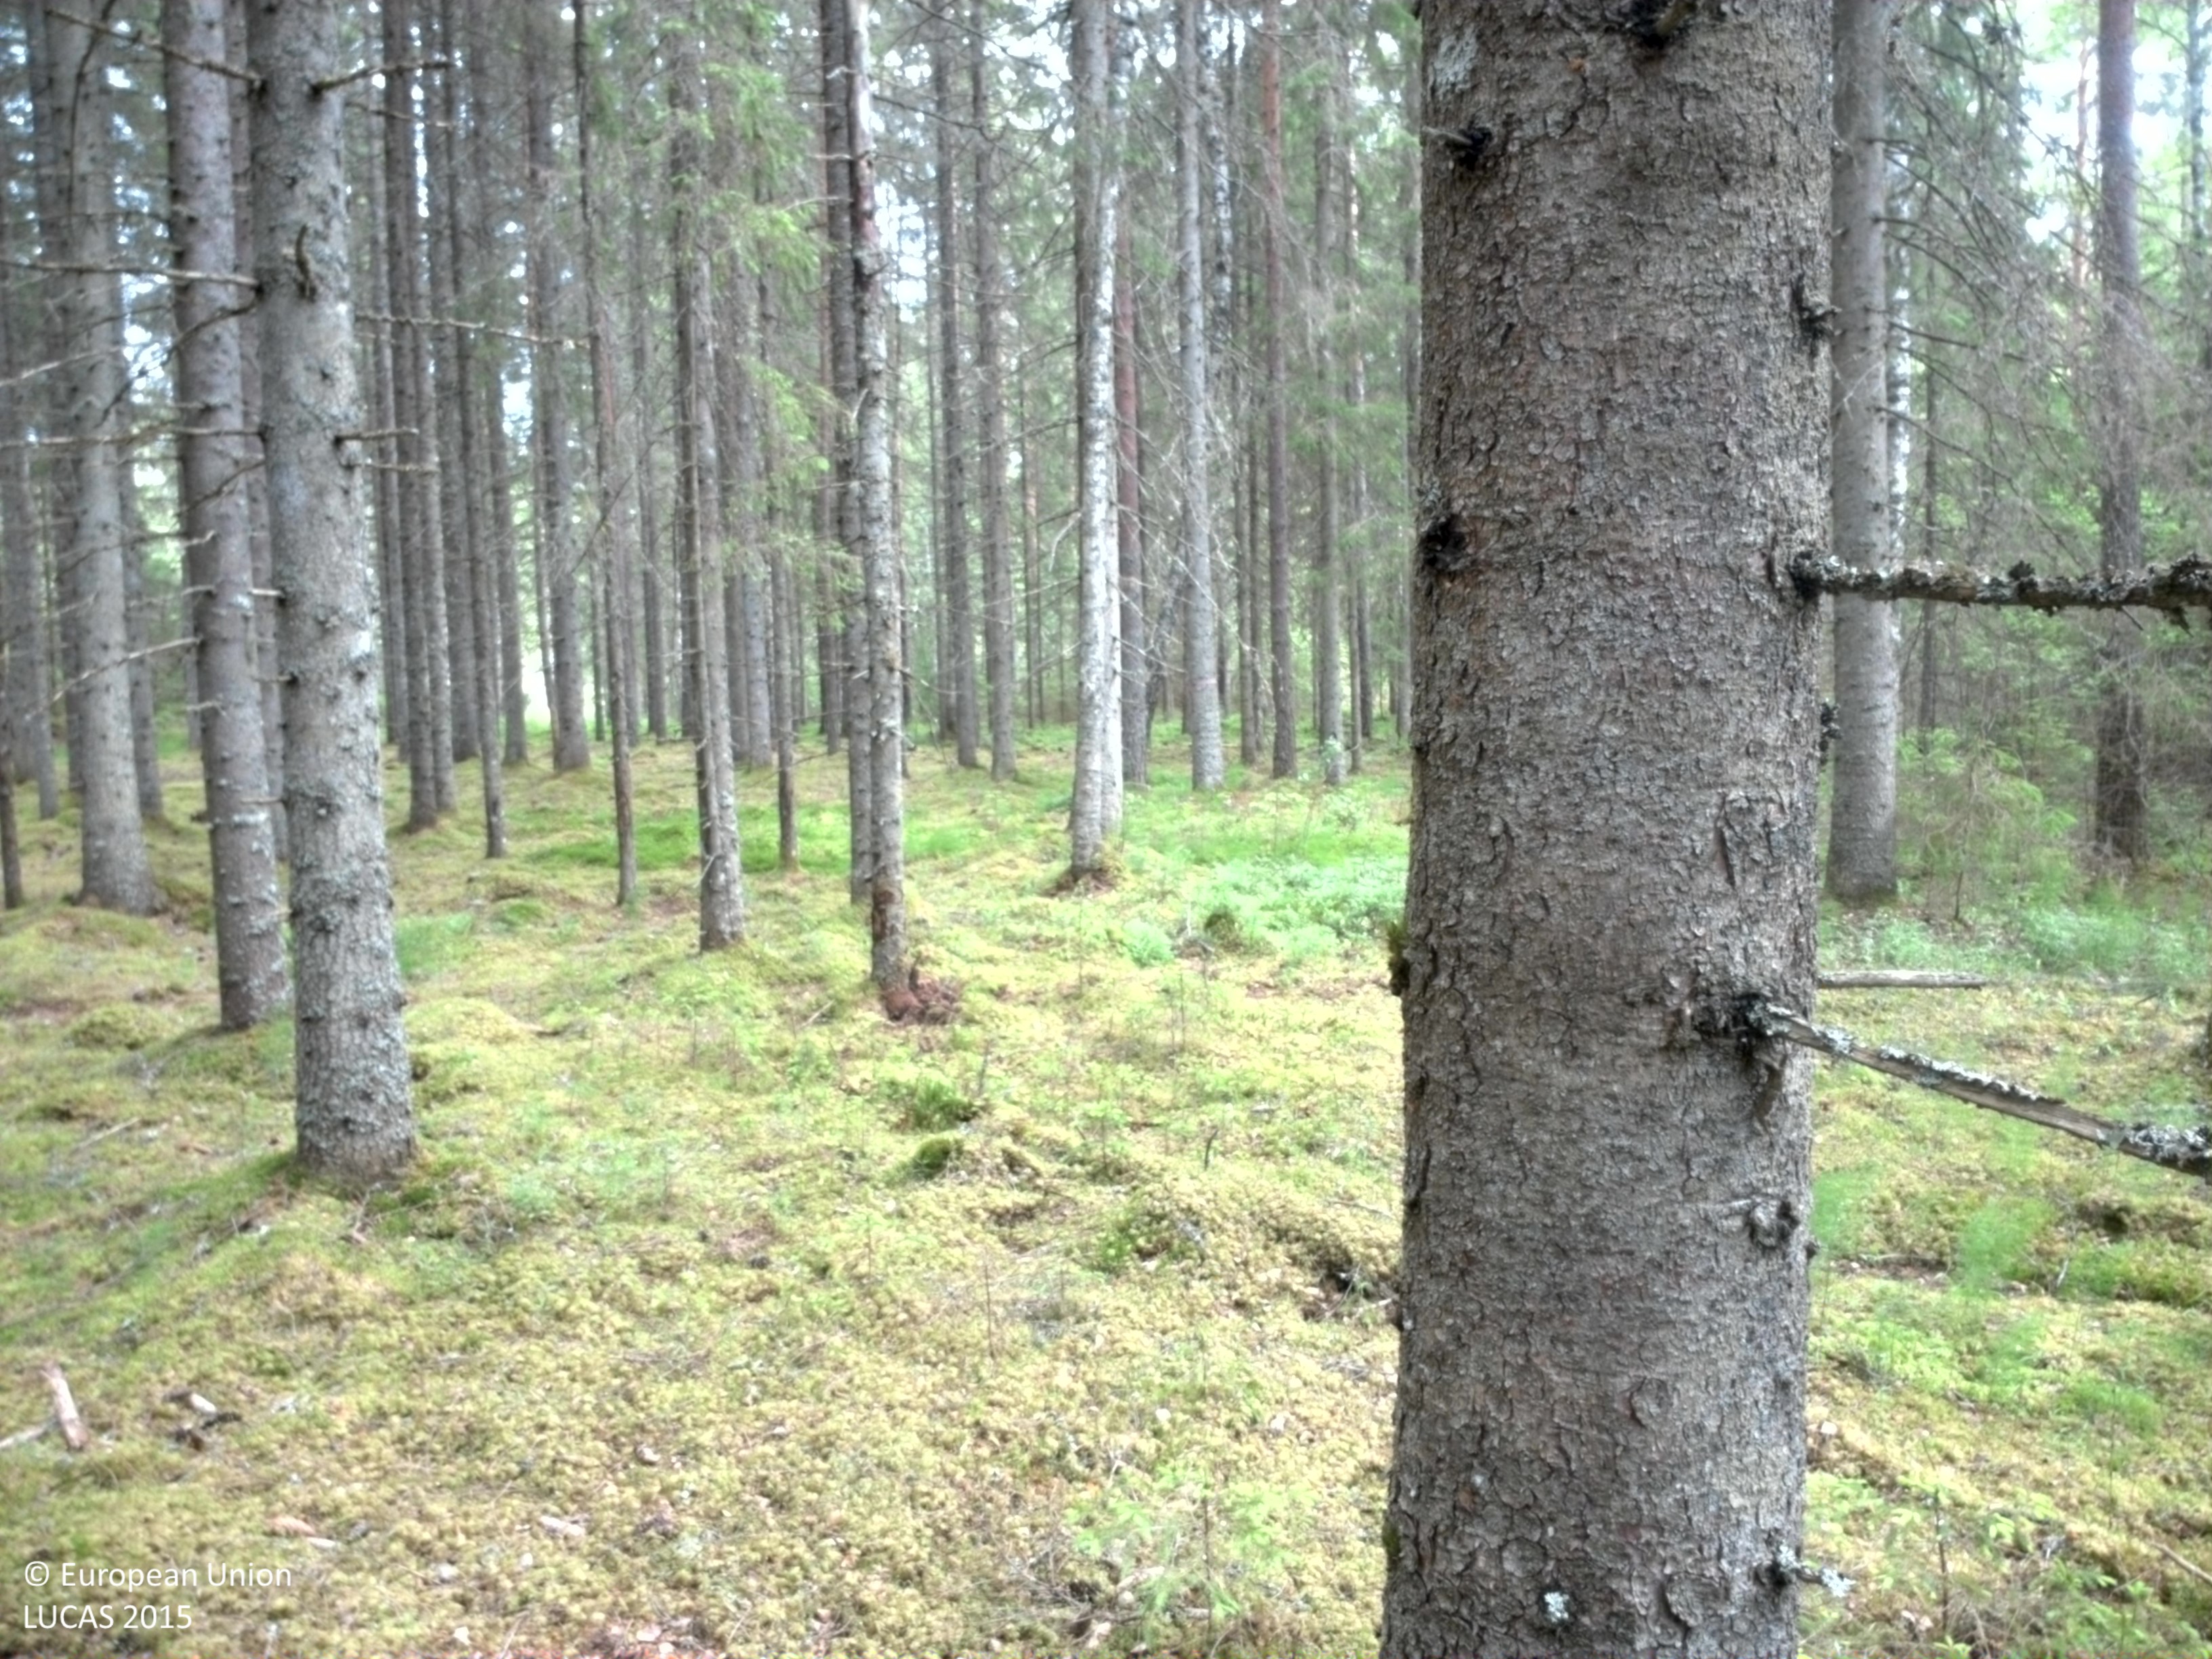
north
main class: Woodland
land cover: Spruce dominated coniferous woodland
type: boreal forest
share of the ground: 50 - 75 %
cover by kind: coniferous forest trees 45 %, lichens and mosses 35 %, broadleaved forest trees 15 %, shrubs 5 %
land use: Forestry
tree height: > 5 m
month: June
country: SE
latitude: 59.8372
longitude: 12.3309
